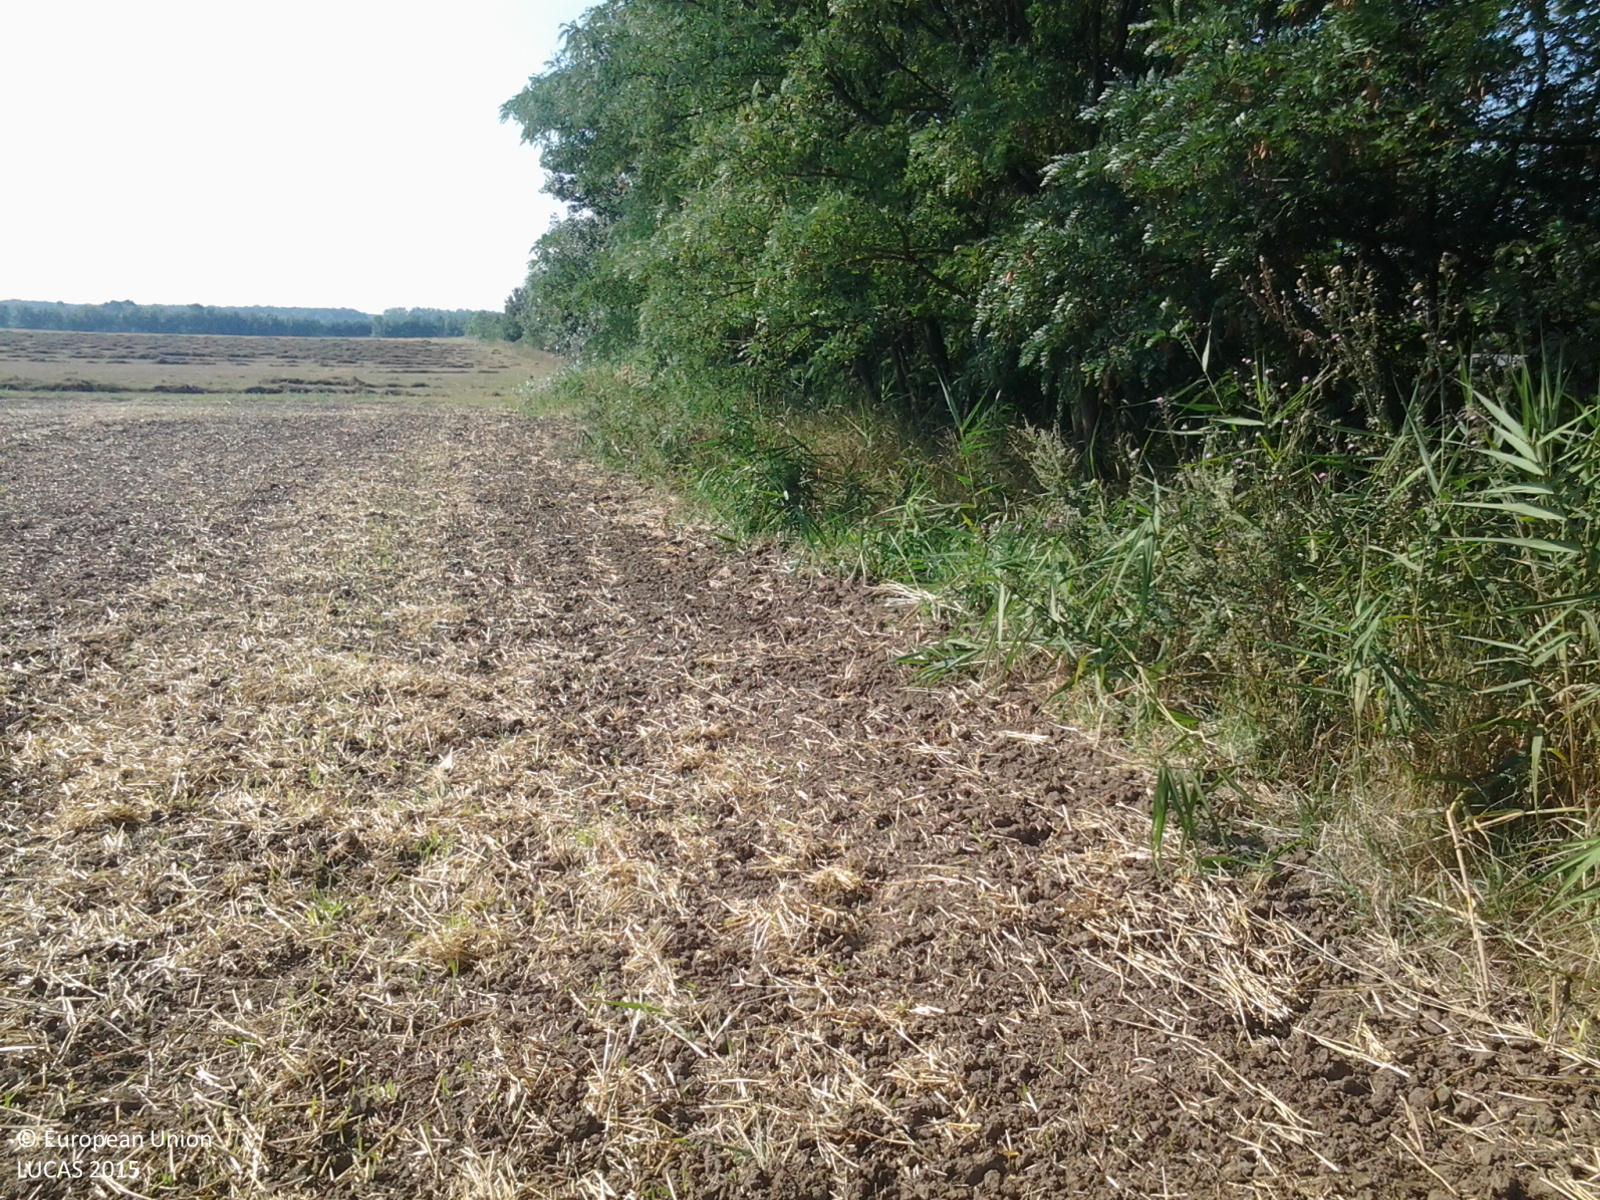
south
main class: Cropland
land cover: Common wheat
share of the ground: < 10 %
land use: Agriculture (excluding fallow land and kitchen gardens)
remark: Harvested field
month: August
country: HU
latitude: 46.9282
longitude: 21.5057
